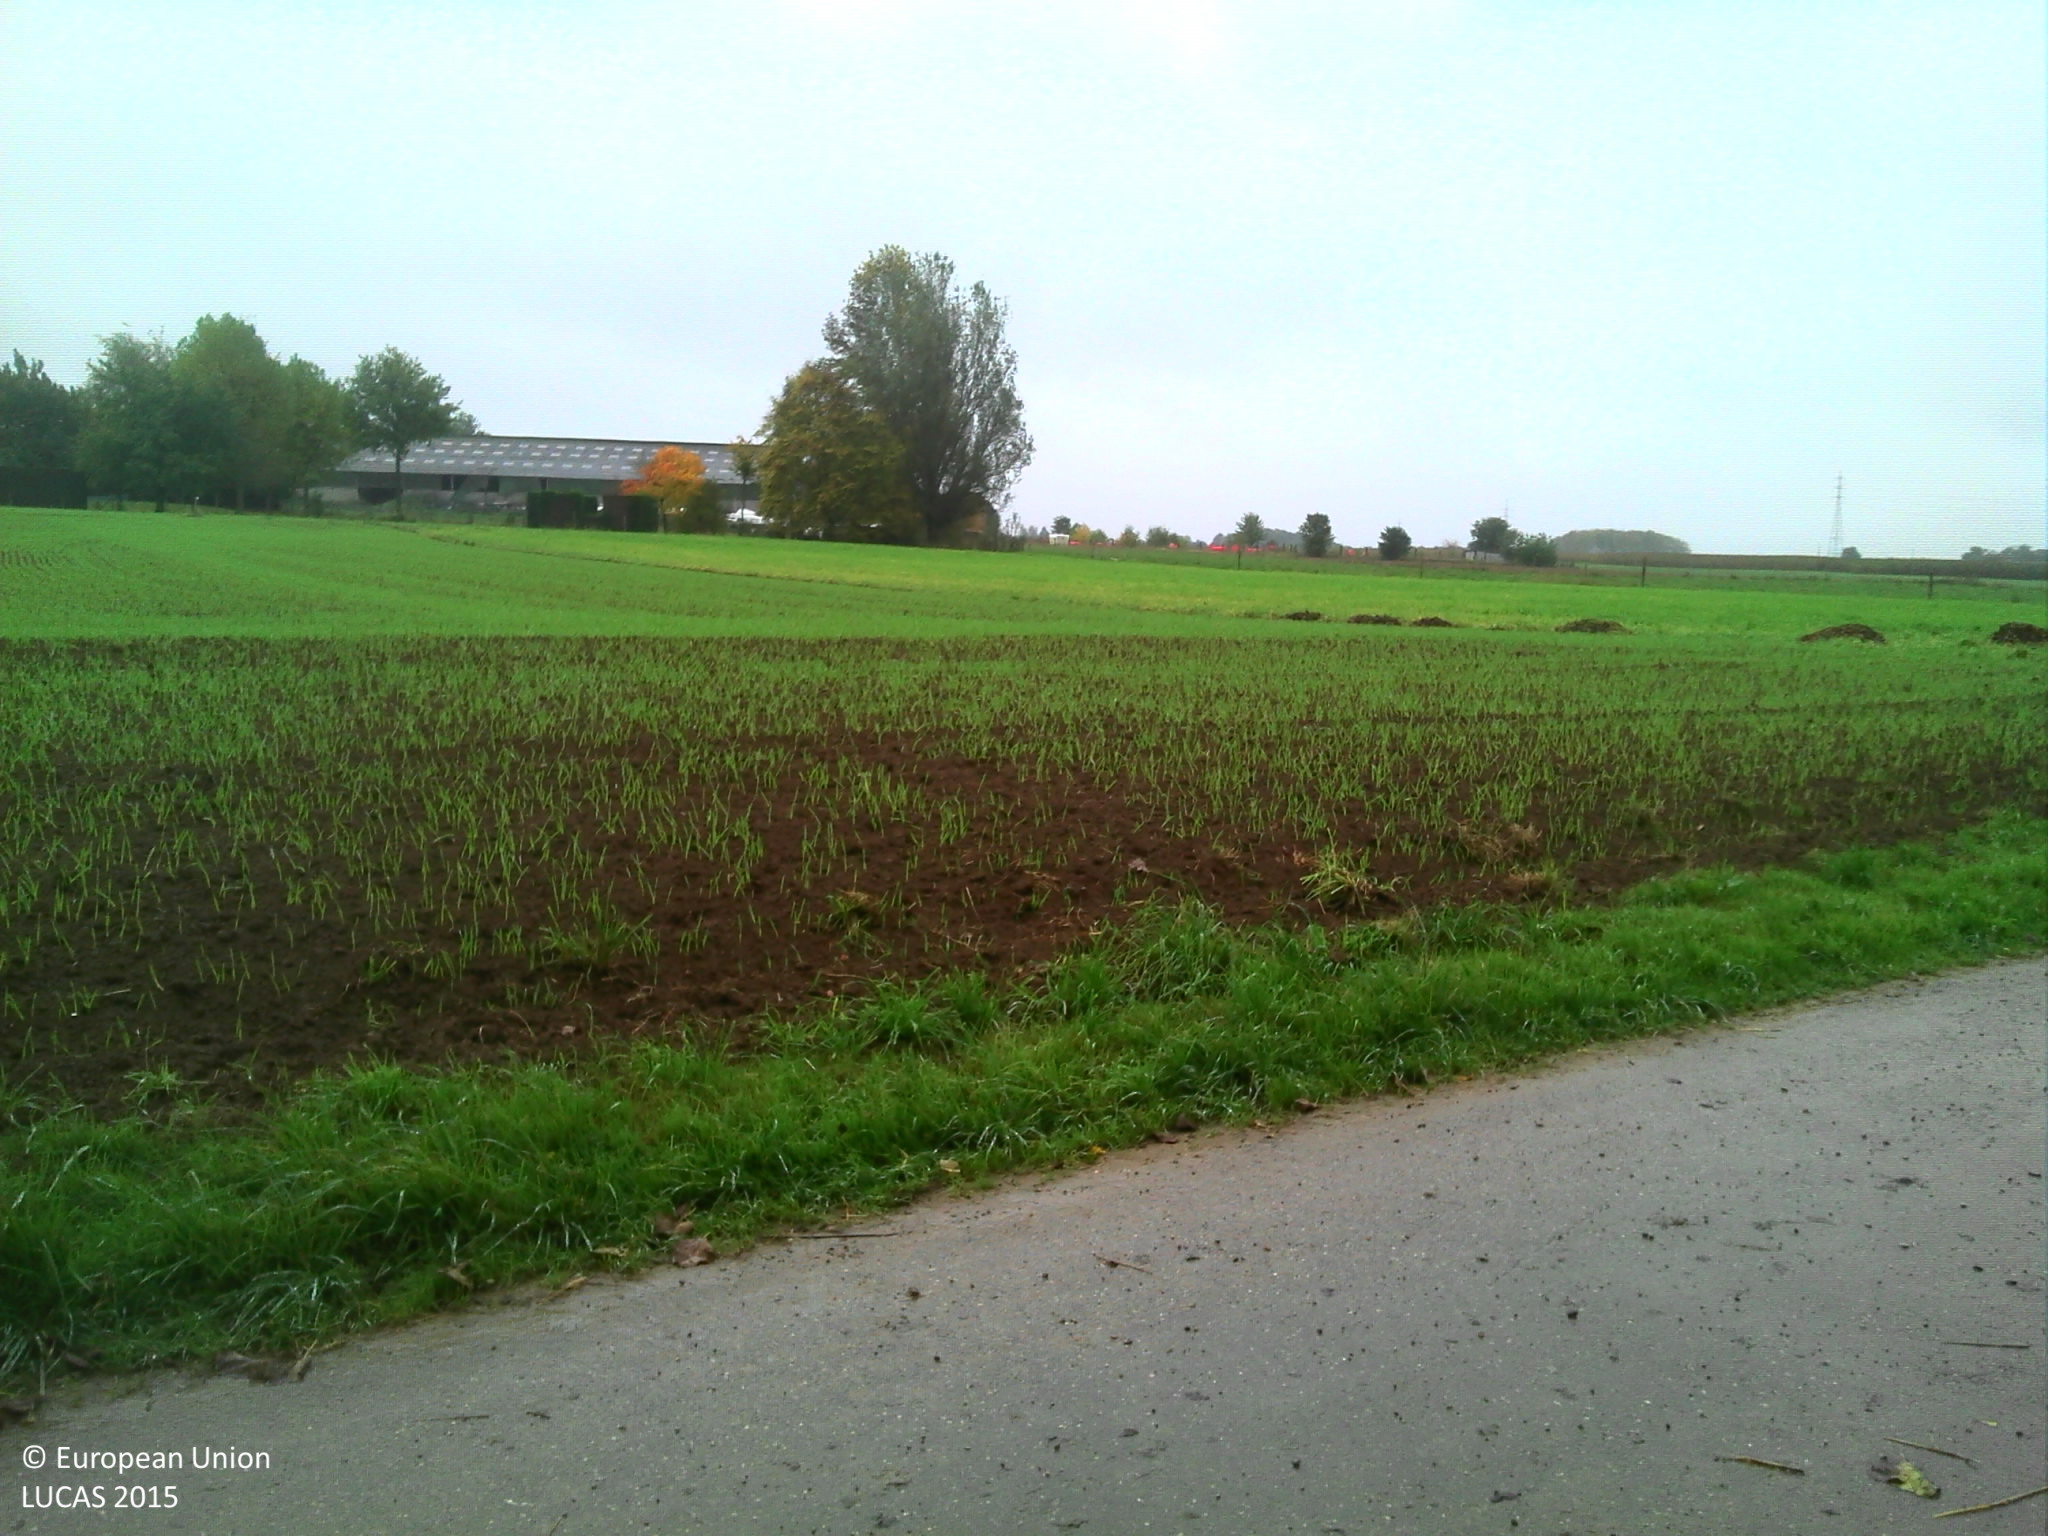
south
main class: Cropland
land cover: Floriculture and ornamental plants
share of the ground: > 75 %
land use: Residential
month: October
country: BE
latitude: 50.9127
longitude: 4.8052
